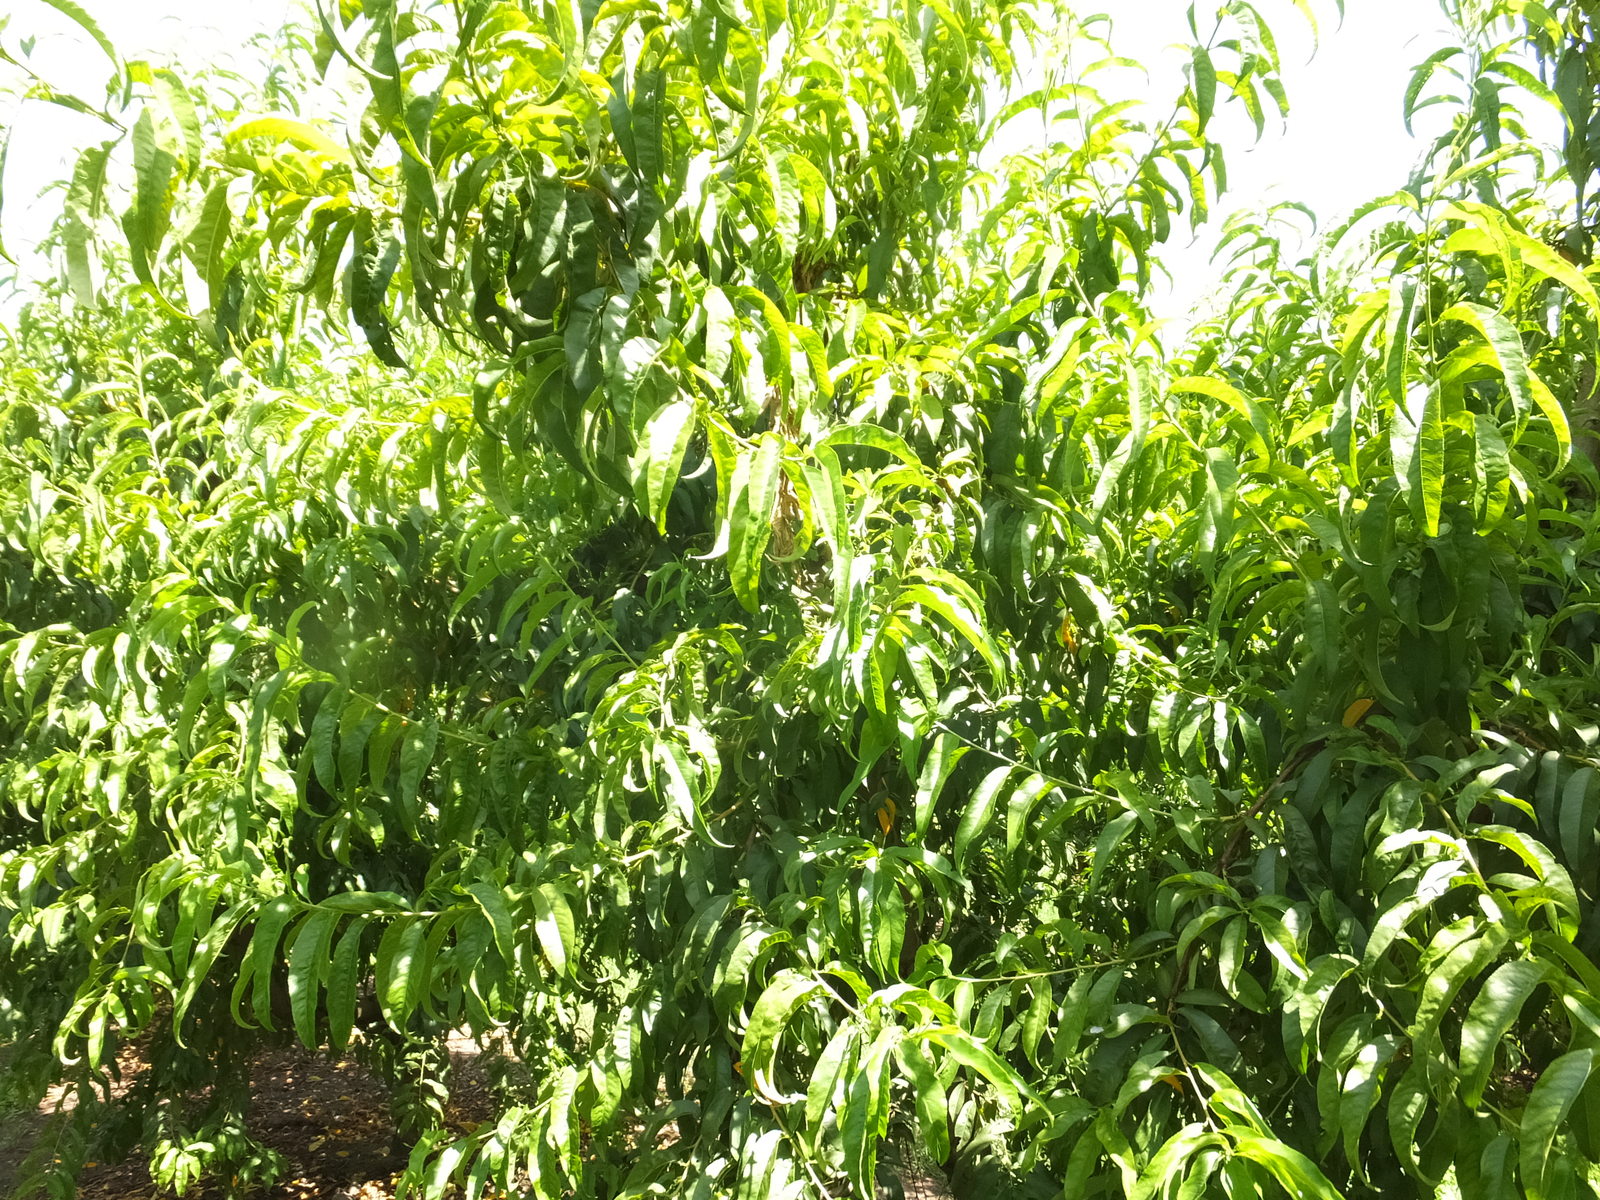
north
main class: Cropland
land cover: Other fruit trees and berries
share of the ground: > 75 %
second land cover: Spontaneously vegetated surfaces
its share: 10 - 25 %
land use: Agriculture (excluding fallow land and kitchen gardens)
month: July
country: ES
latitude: 41.5145
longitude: 0.4860
